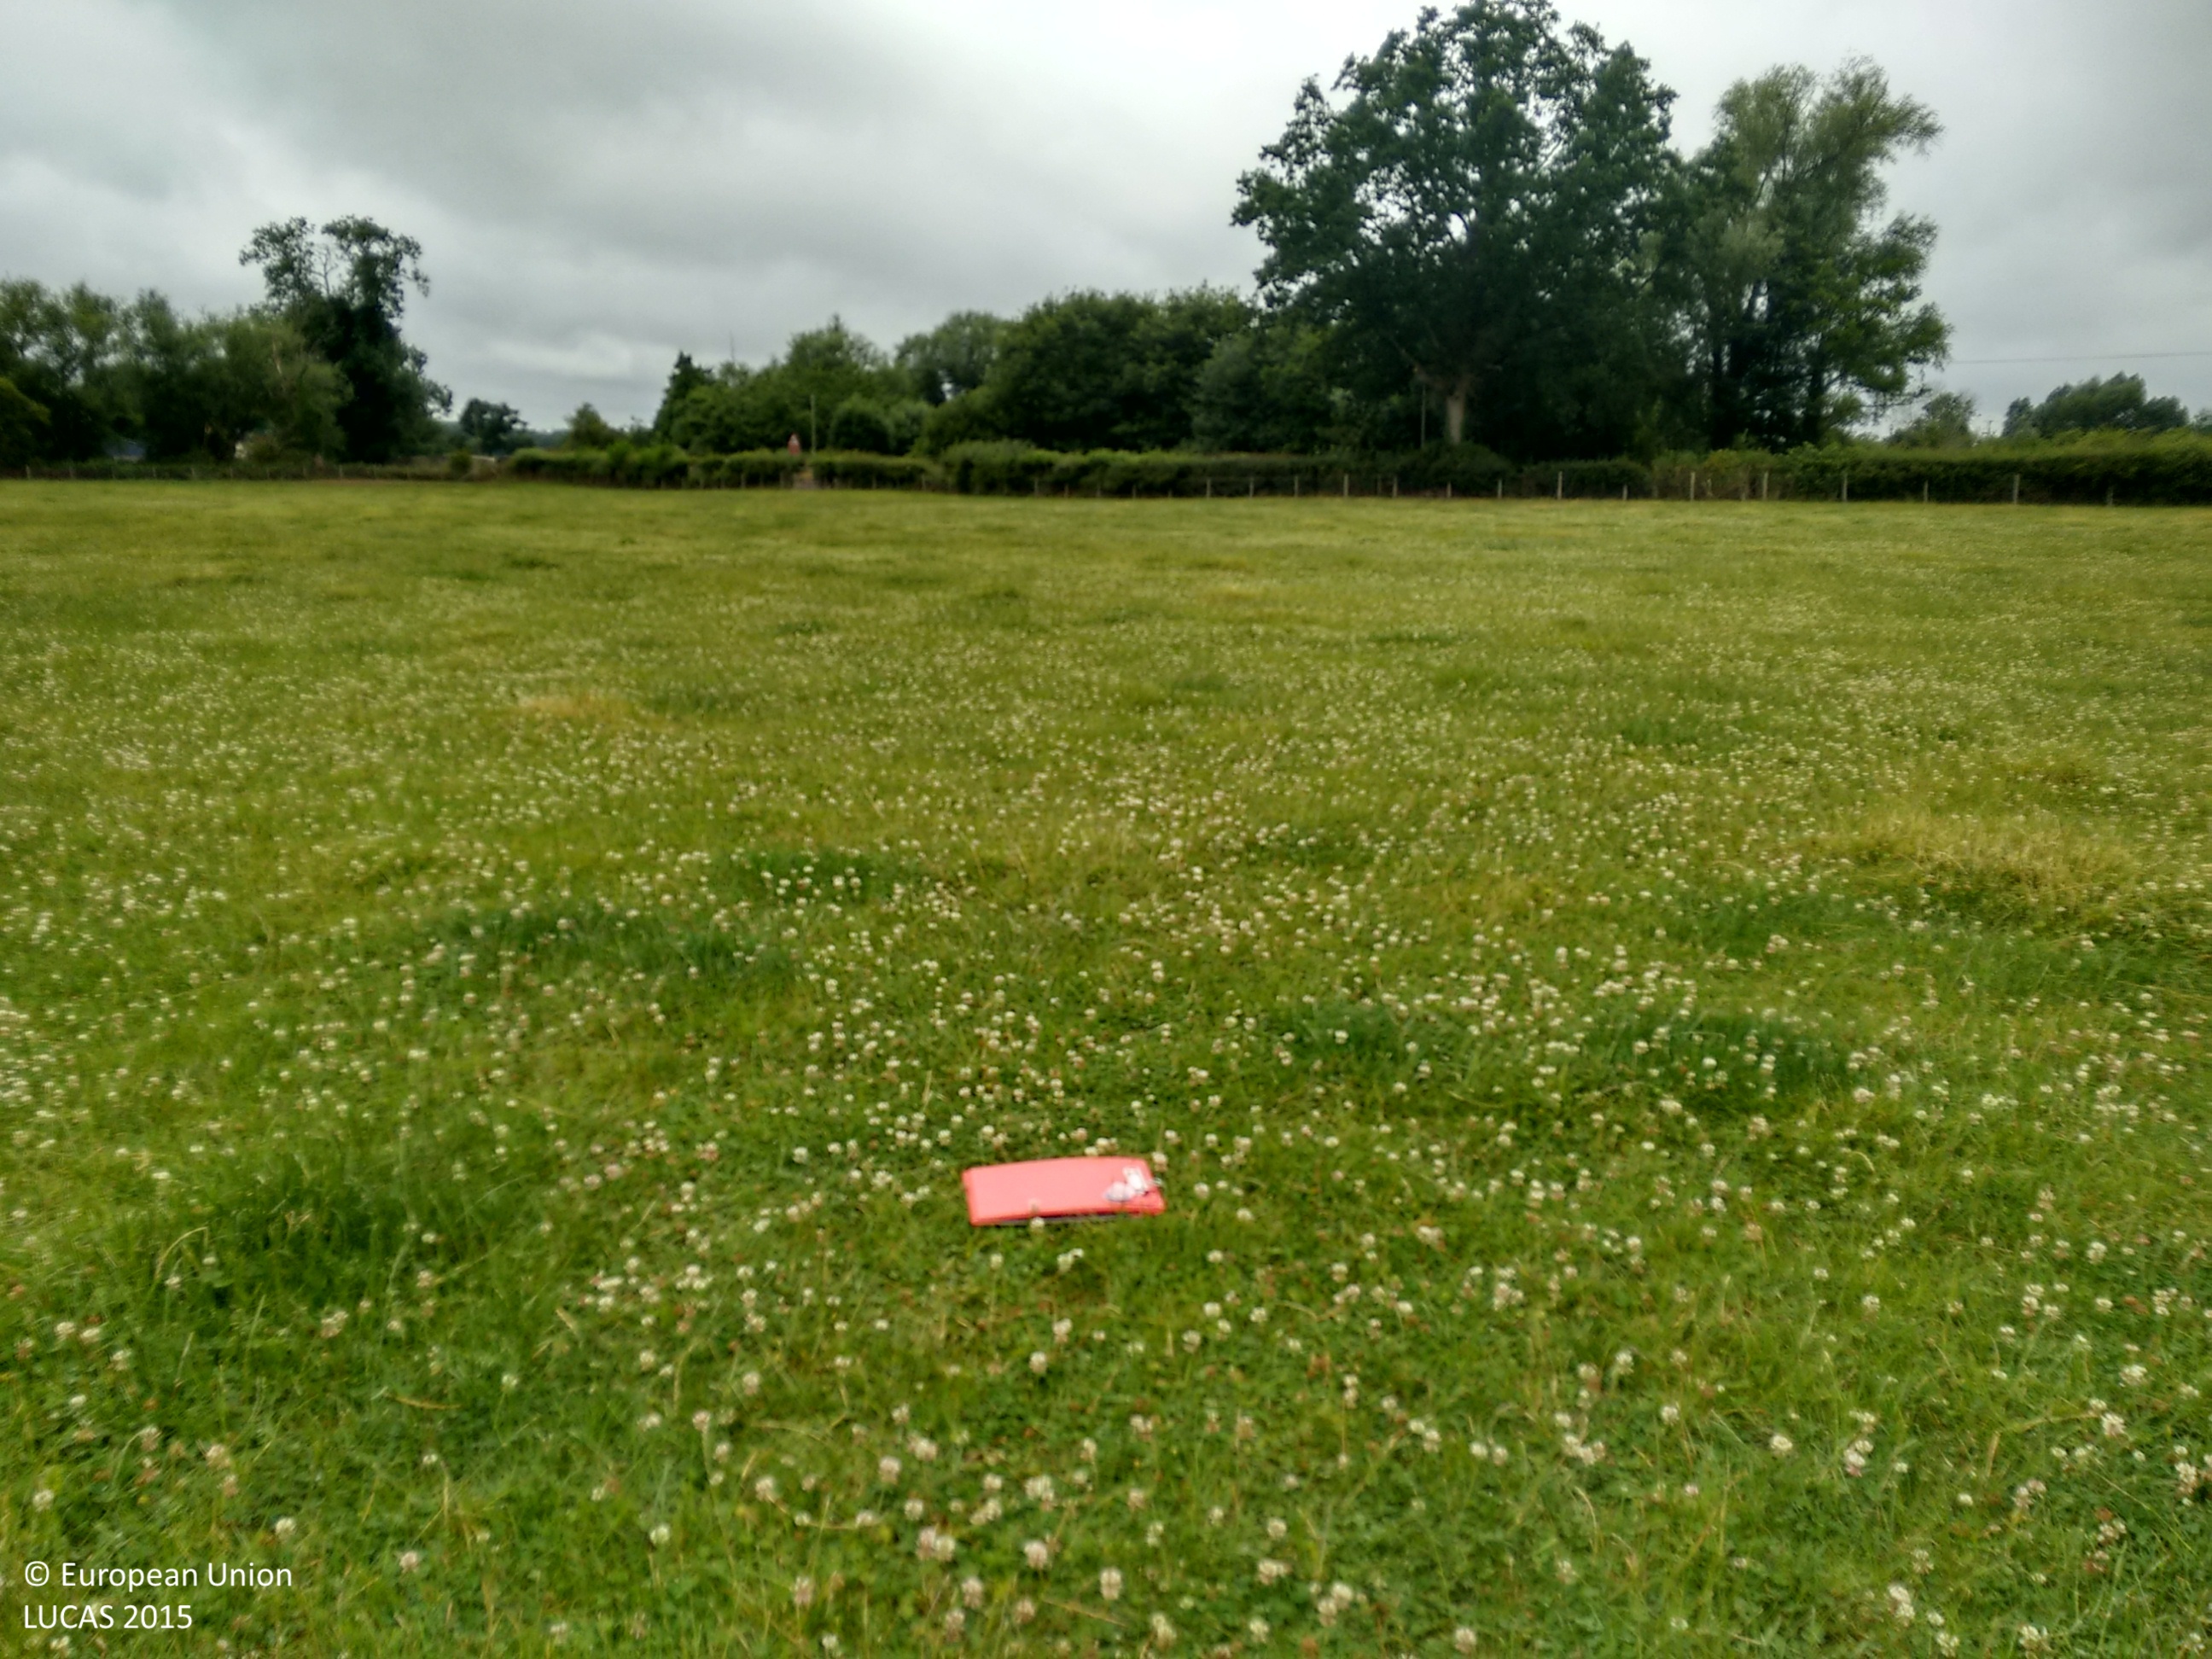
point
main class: Grassland
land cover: Grassland without tree/shrub cover
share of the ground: > 75 %
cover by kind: herbaceous plants 100 %
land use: Agriculture (excluding fallow land and kitchen gardens)
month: July
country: GB
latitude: 52.2248
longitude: -2.8228
